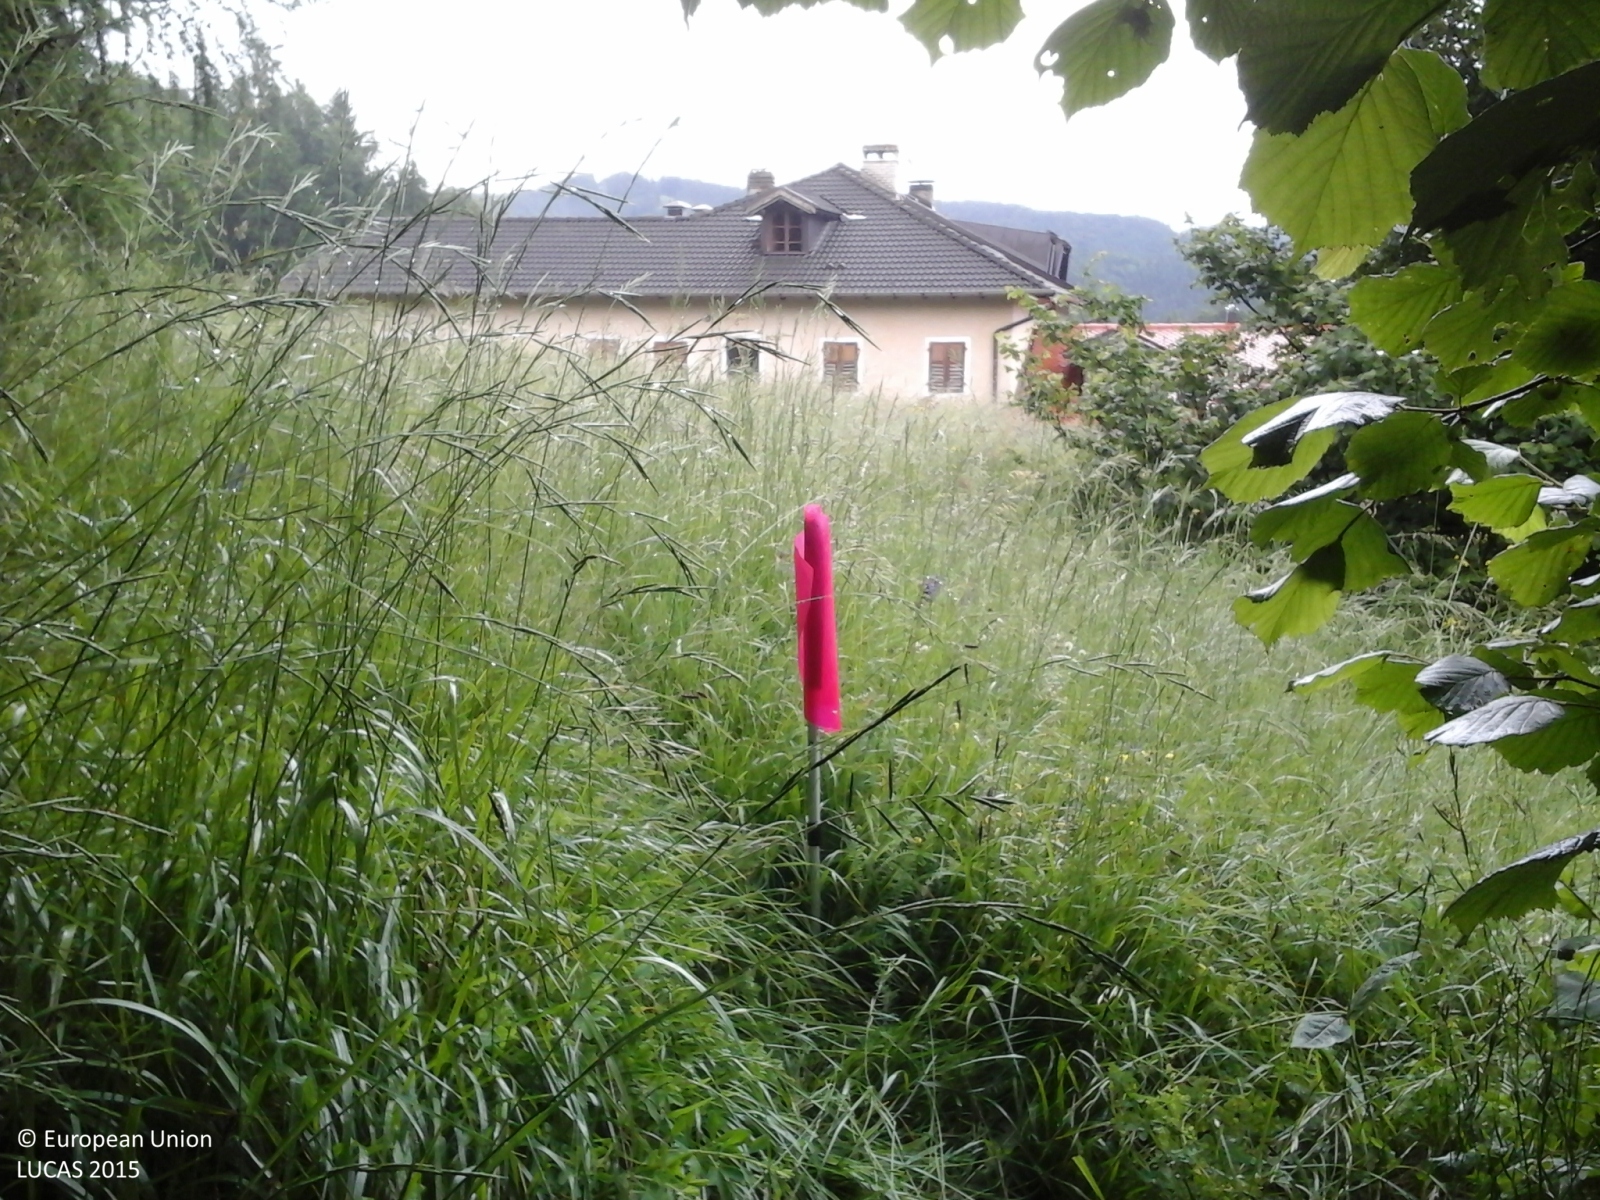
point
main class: Woodland
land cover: Other mixed woodland
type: alpine coniferous forest
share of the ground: > 75 %
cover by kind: shrubs 30 %, coniferous forest trees 25 %, broadleaved forest trees 25 %, herbaceous plants 20 %
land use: Forestry
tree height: > 5 m
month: June
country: IT
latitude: 45.9475
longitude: 11.2495
